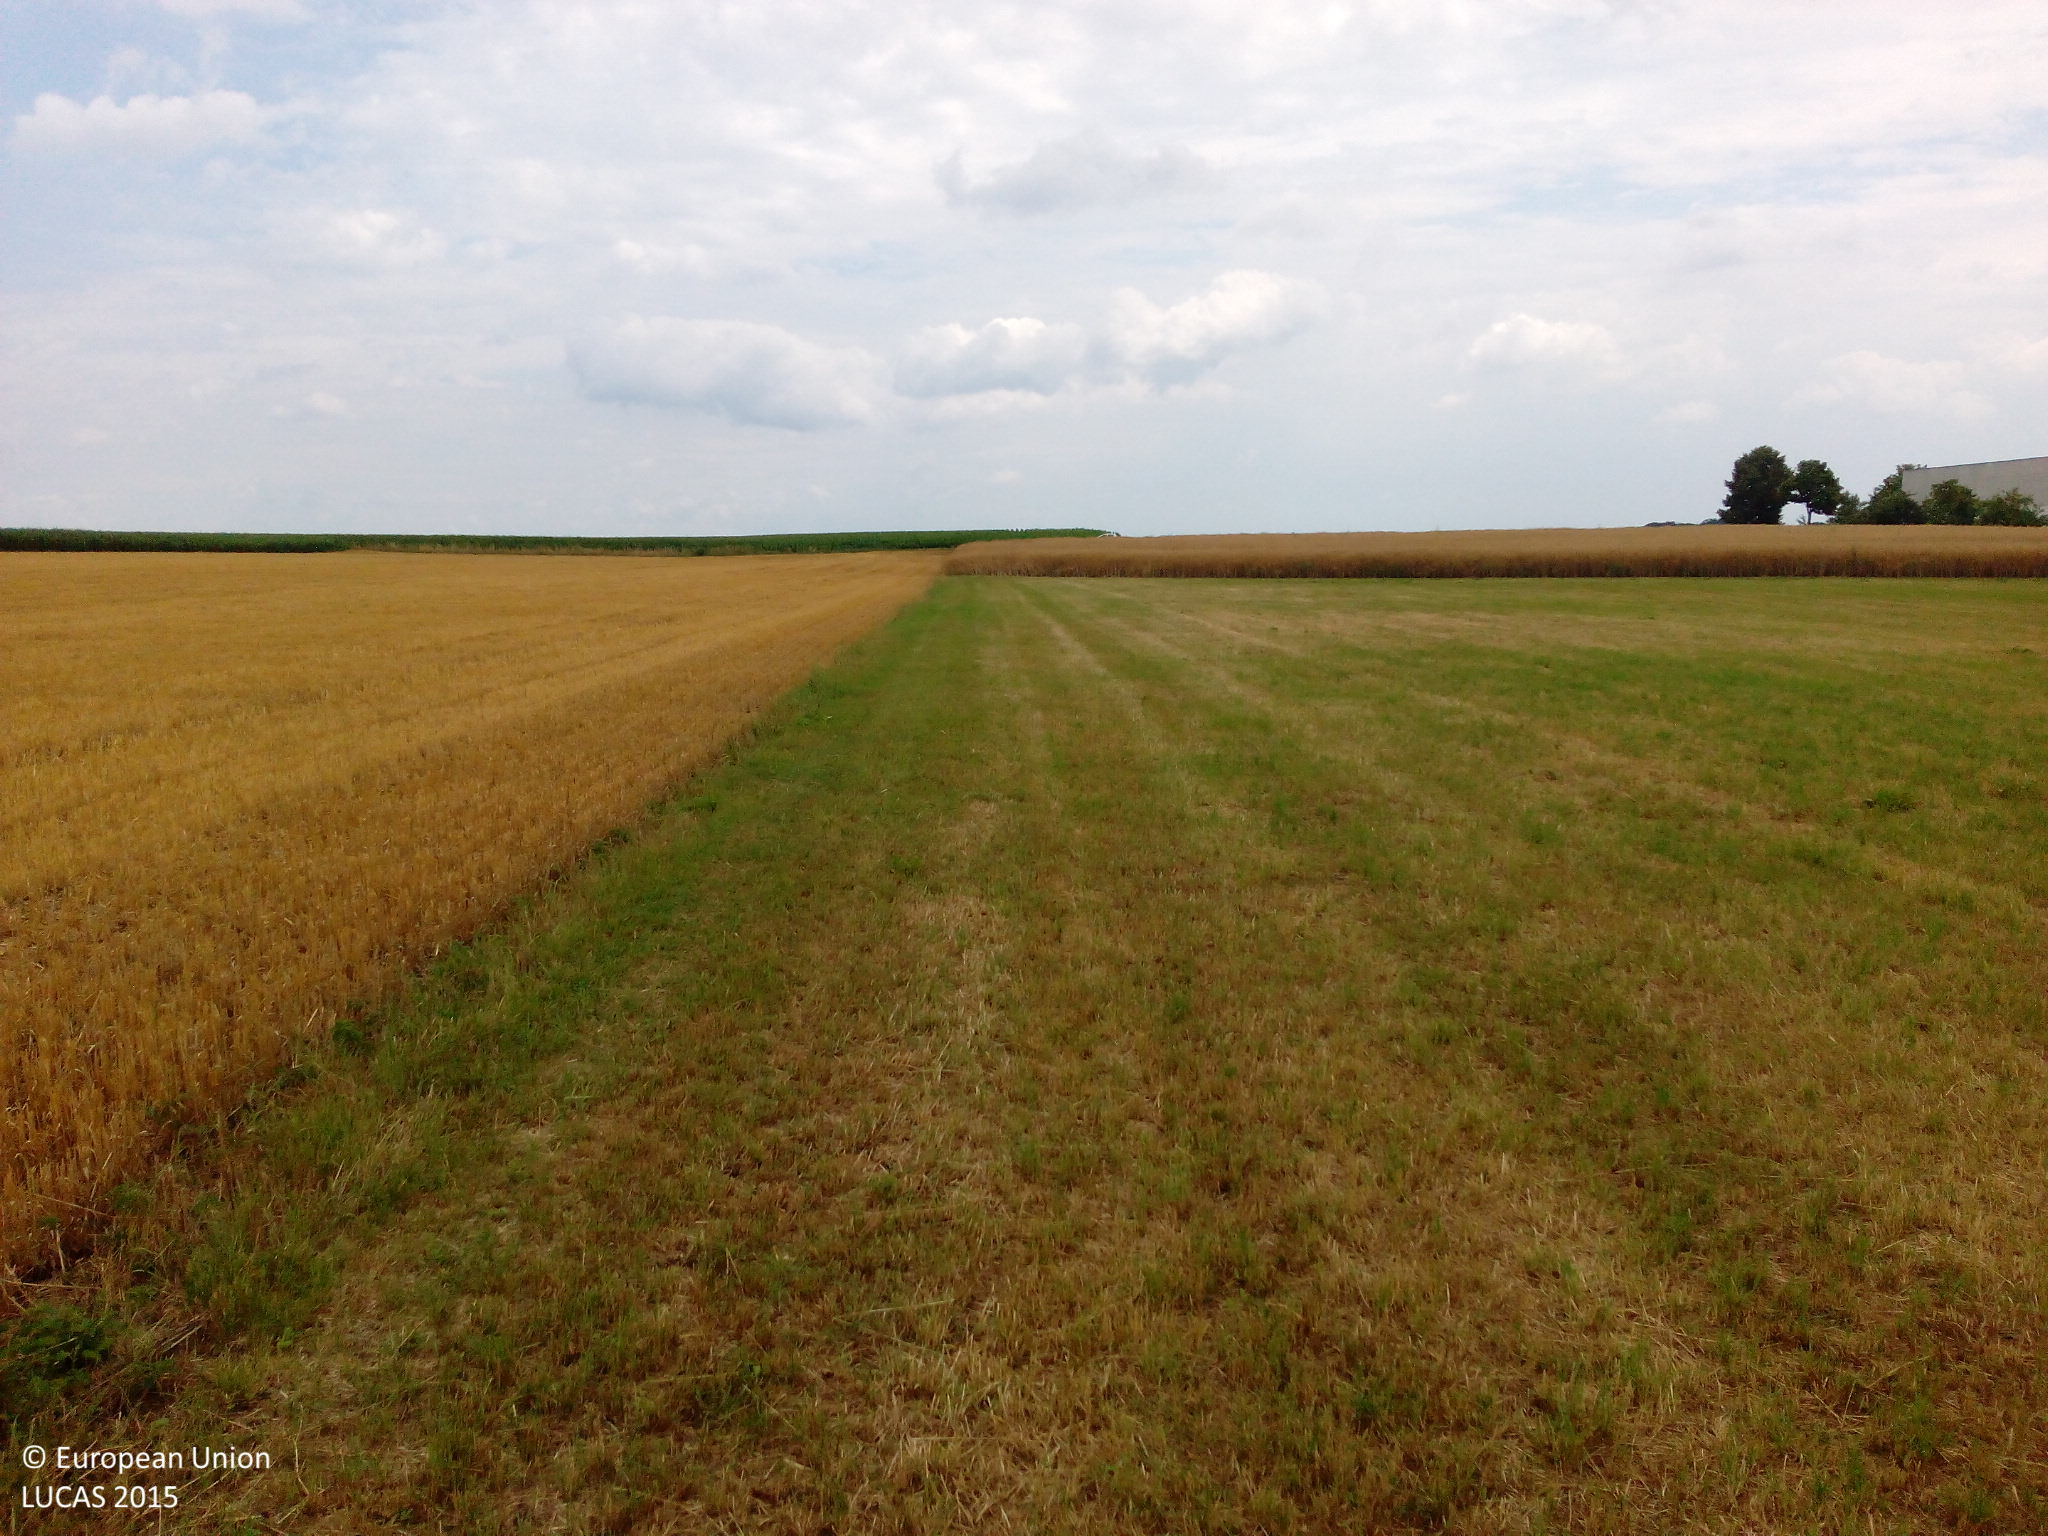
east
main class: Grassland
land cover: Grassland without tree/shrub cover
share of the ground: > 75 %
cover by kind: herbaceous plants 90 %, unconsolidated bare surface 10 %
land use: Agriculture (excluding fallow land and kitchen gardens)
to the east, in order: Grassland without tree/shrub cover; Rape and turnip rape; Grass margins; Paved roads, cycling and walking lanes; Grass margins; Maize
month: July
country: DE
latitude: 49.5330
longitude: 10.9254
